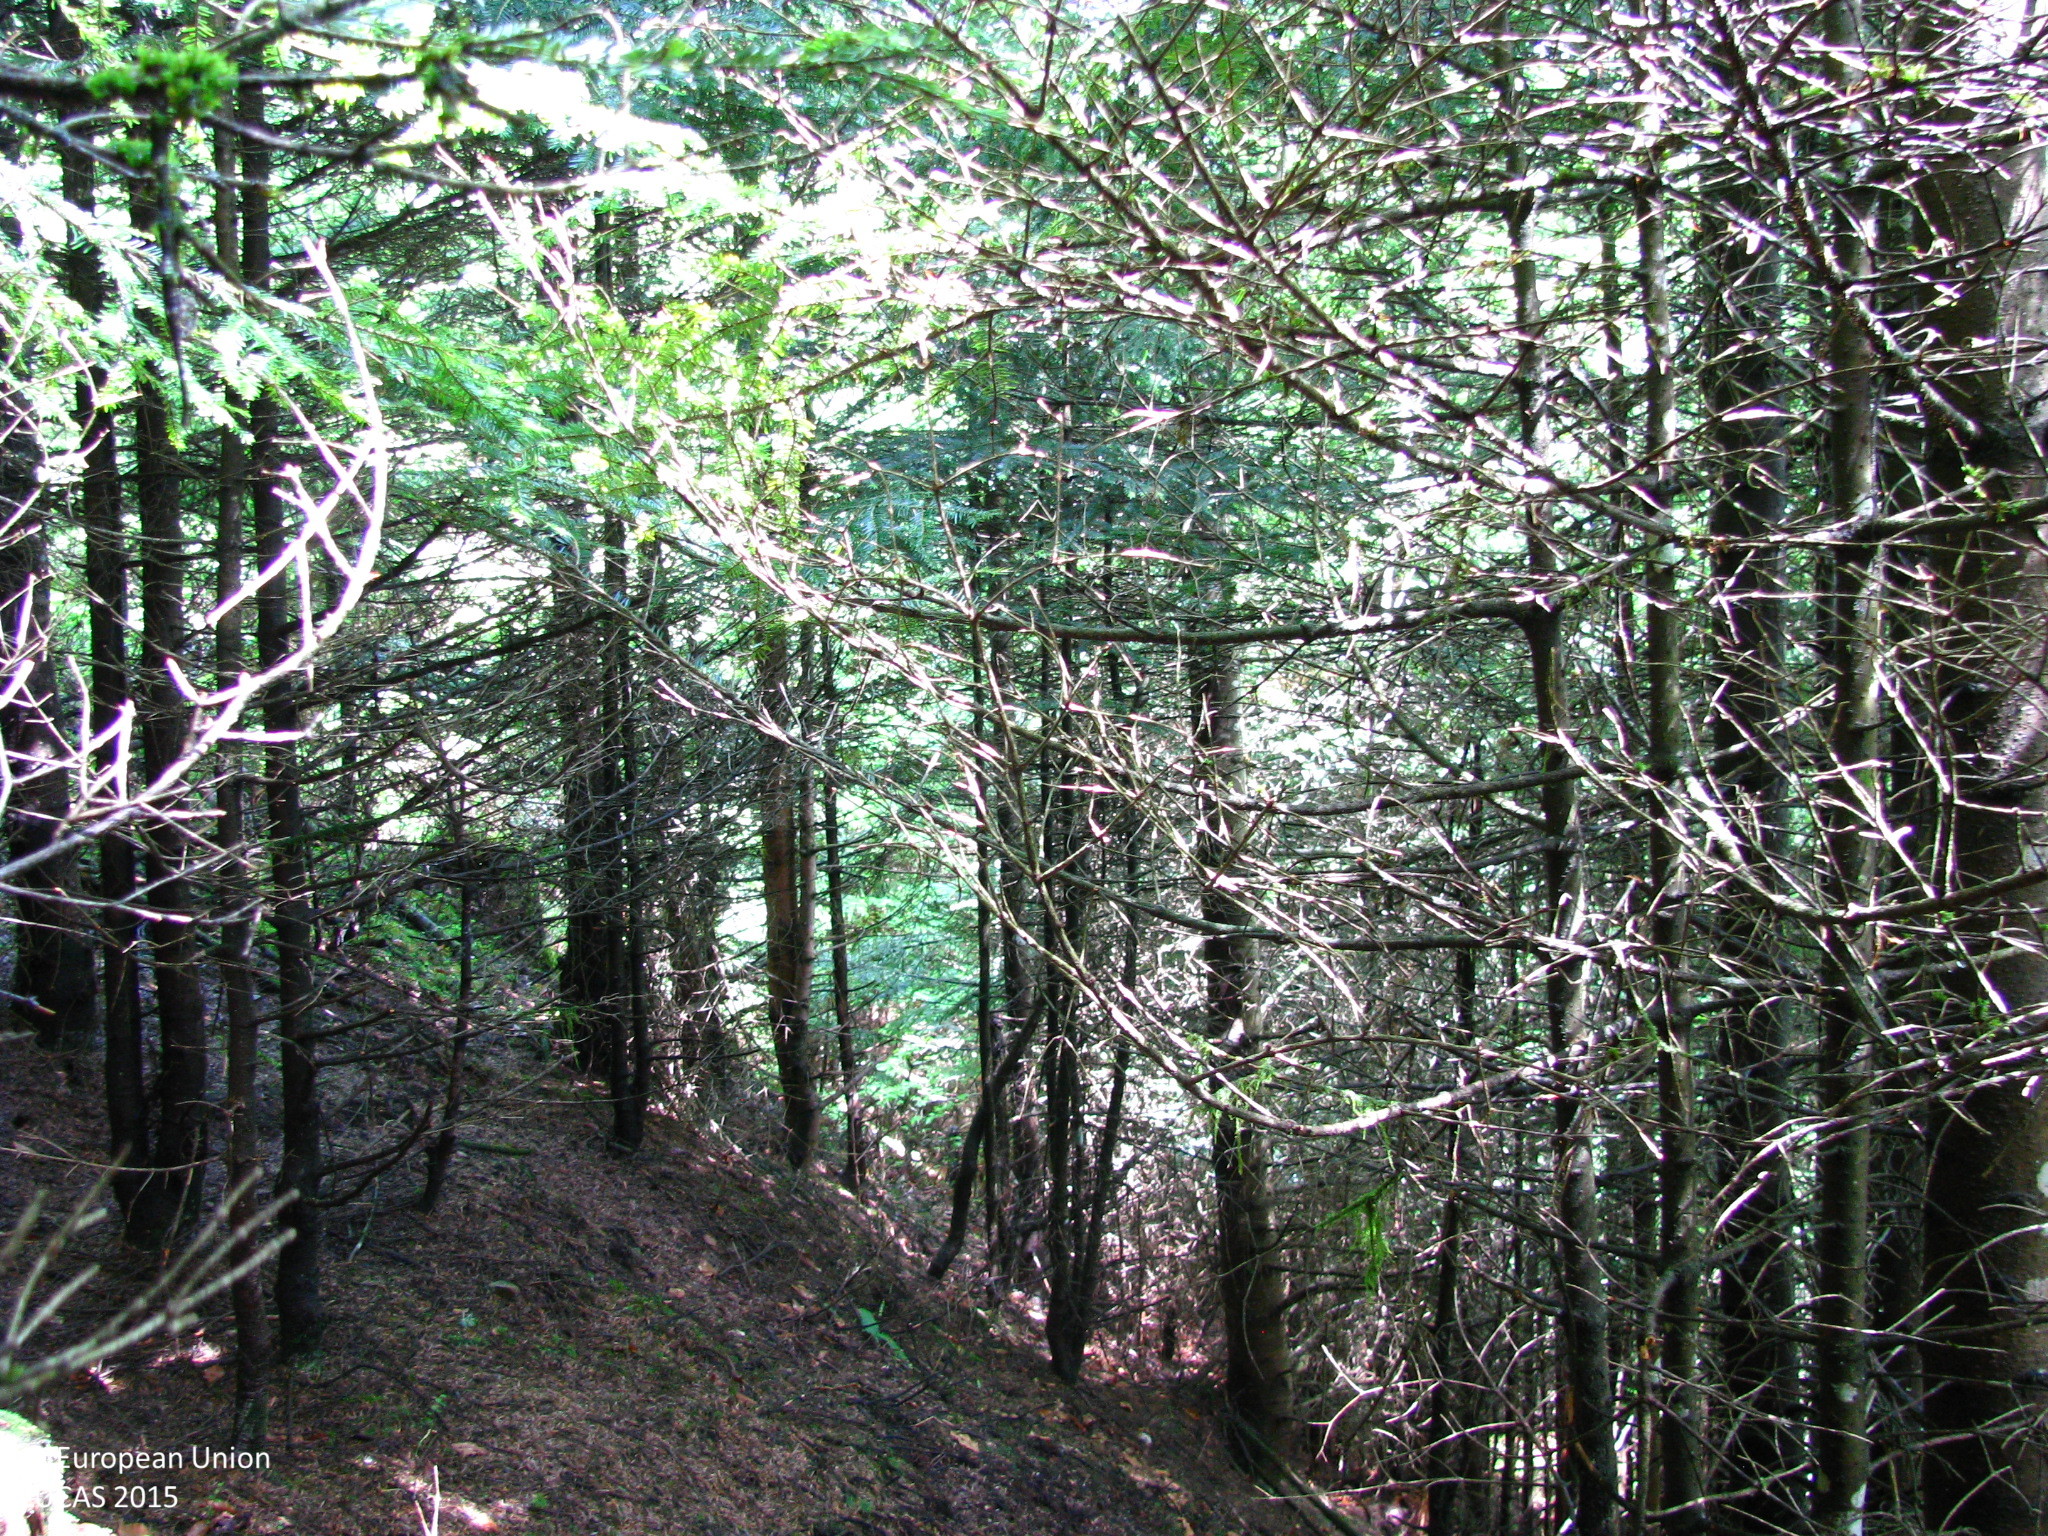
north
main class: Woodland
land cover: Other coniferous woodland
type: alpine coniferous forest
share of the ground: > 75 %
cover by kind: coniferous forest trees 90 %, broadleaved forest trees 5 %, herbaceous plants 5 %
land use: Forestry
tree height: > 5 m
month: May
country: AT
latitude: 47.5928
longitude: 14.4543
